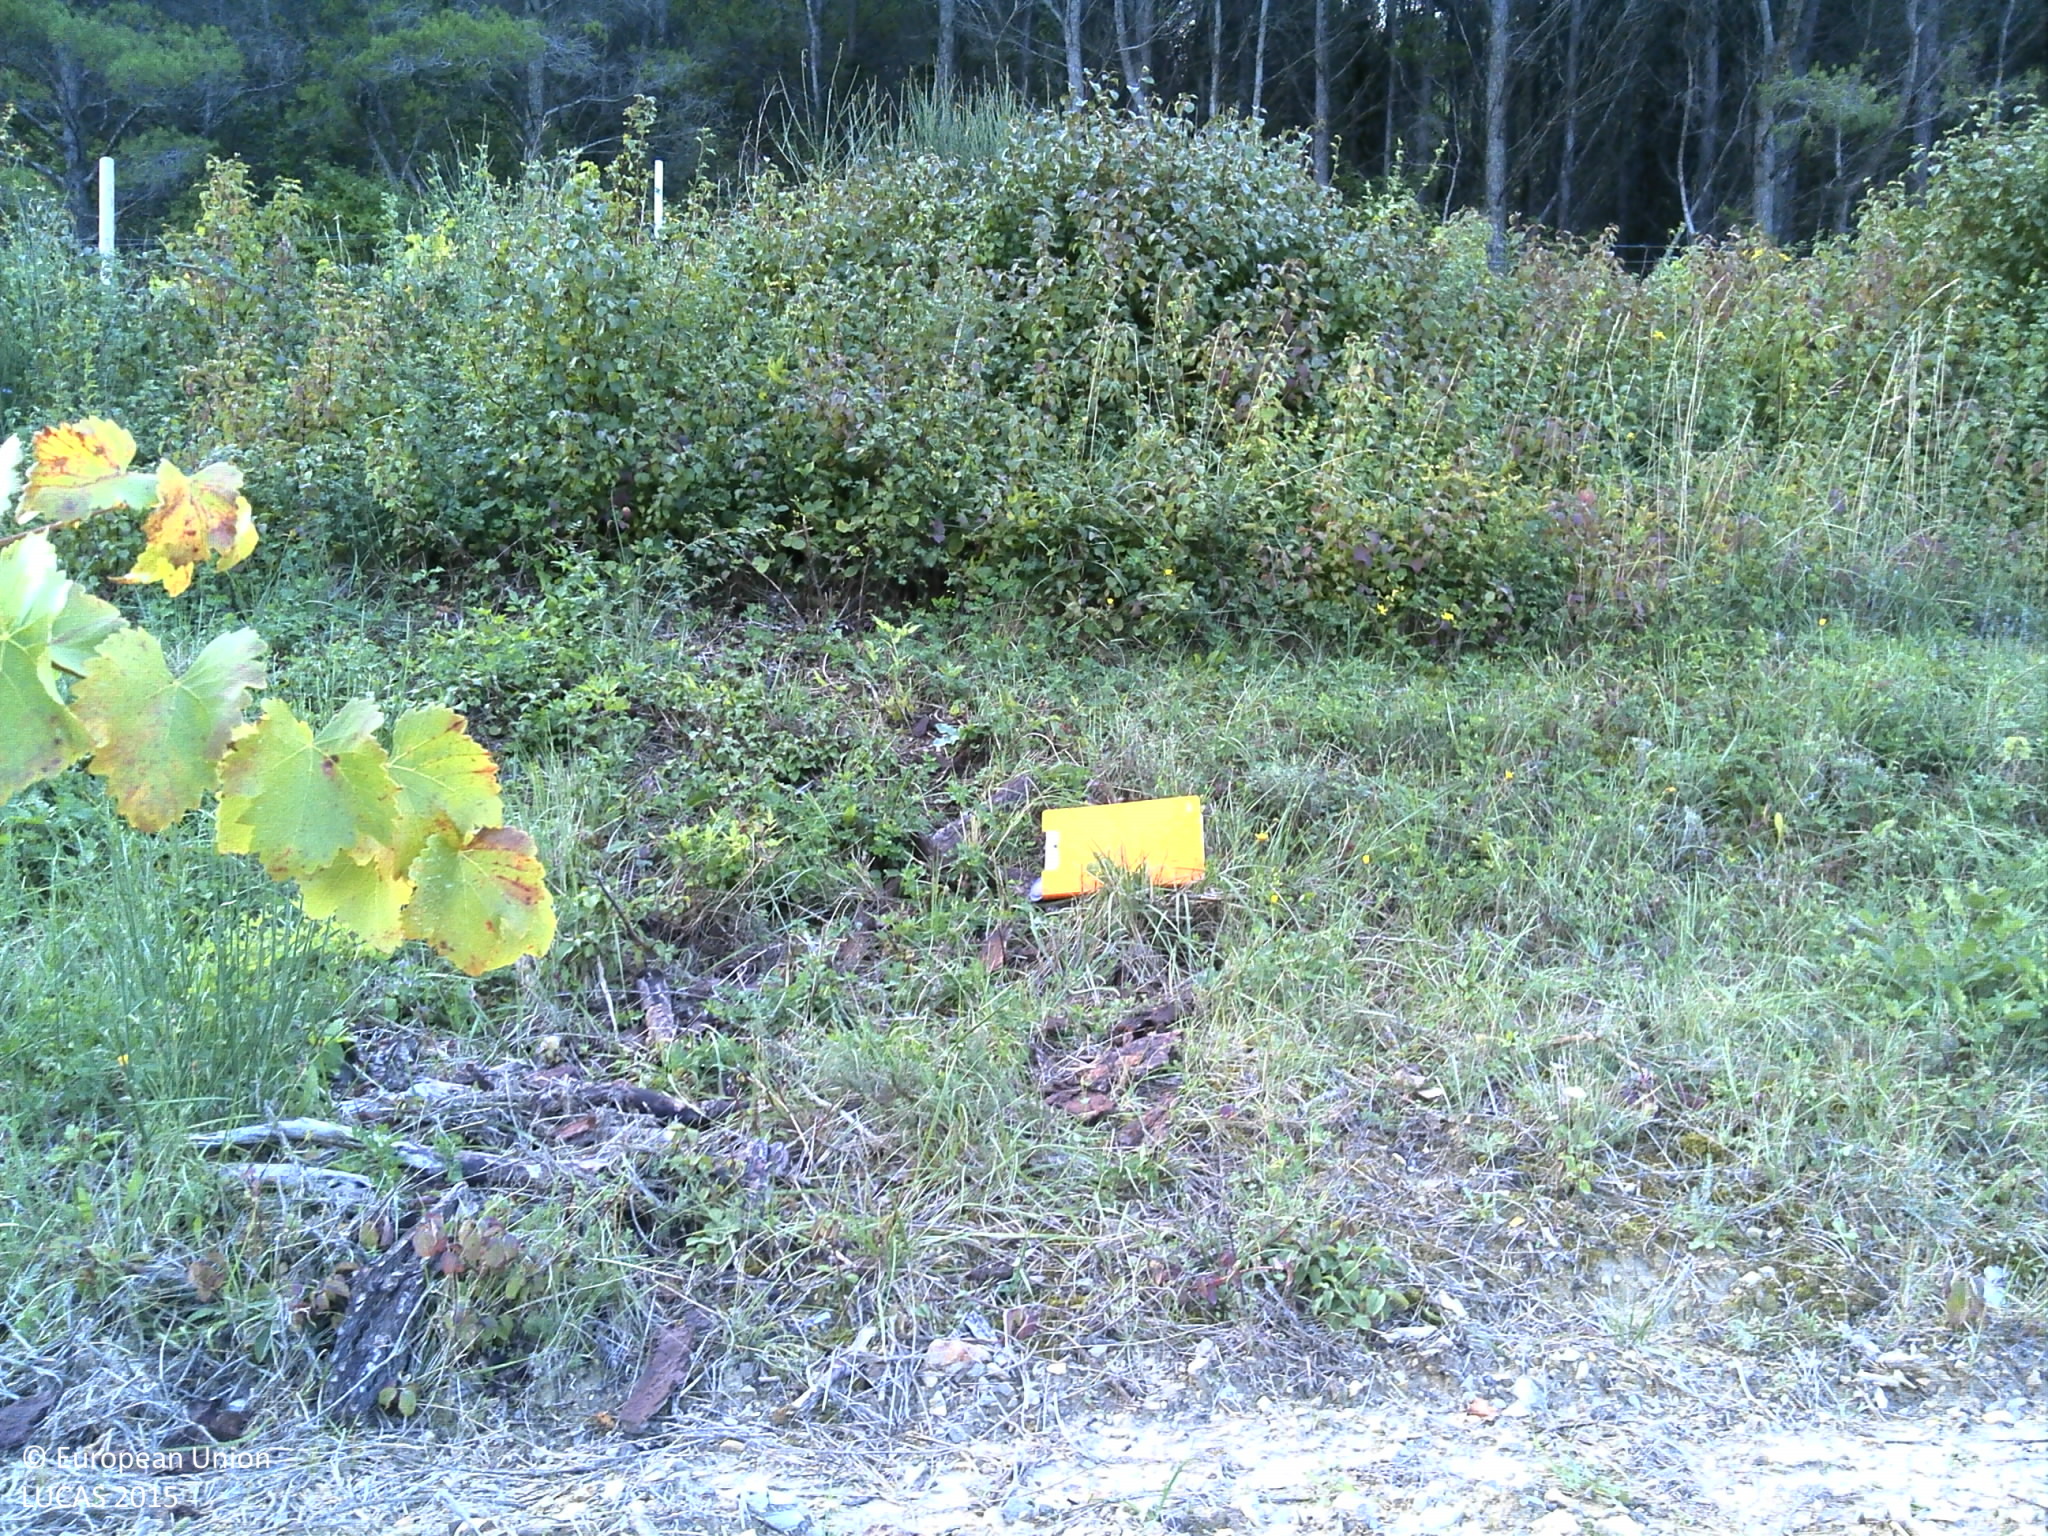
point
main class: Grassland
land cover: Grassland without tree/shrub cover
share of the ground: > 75 %
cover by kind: herbaceous plants 100 %
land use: Agriculture (excluding fallow land and kitchen gardens)
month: July
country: FR
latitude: 44.1587
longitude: 5.0188
